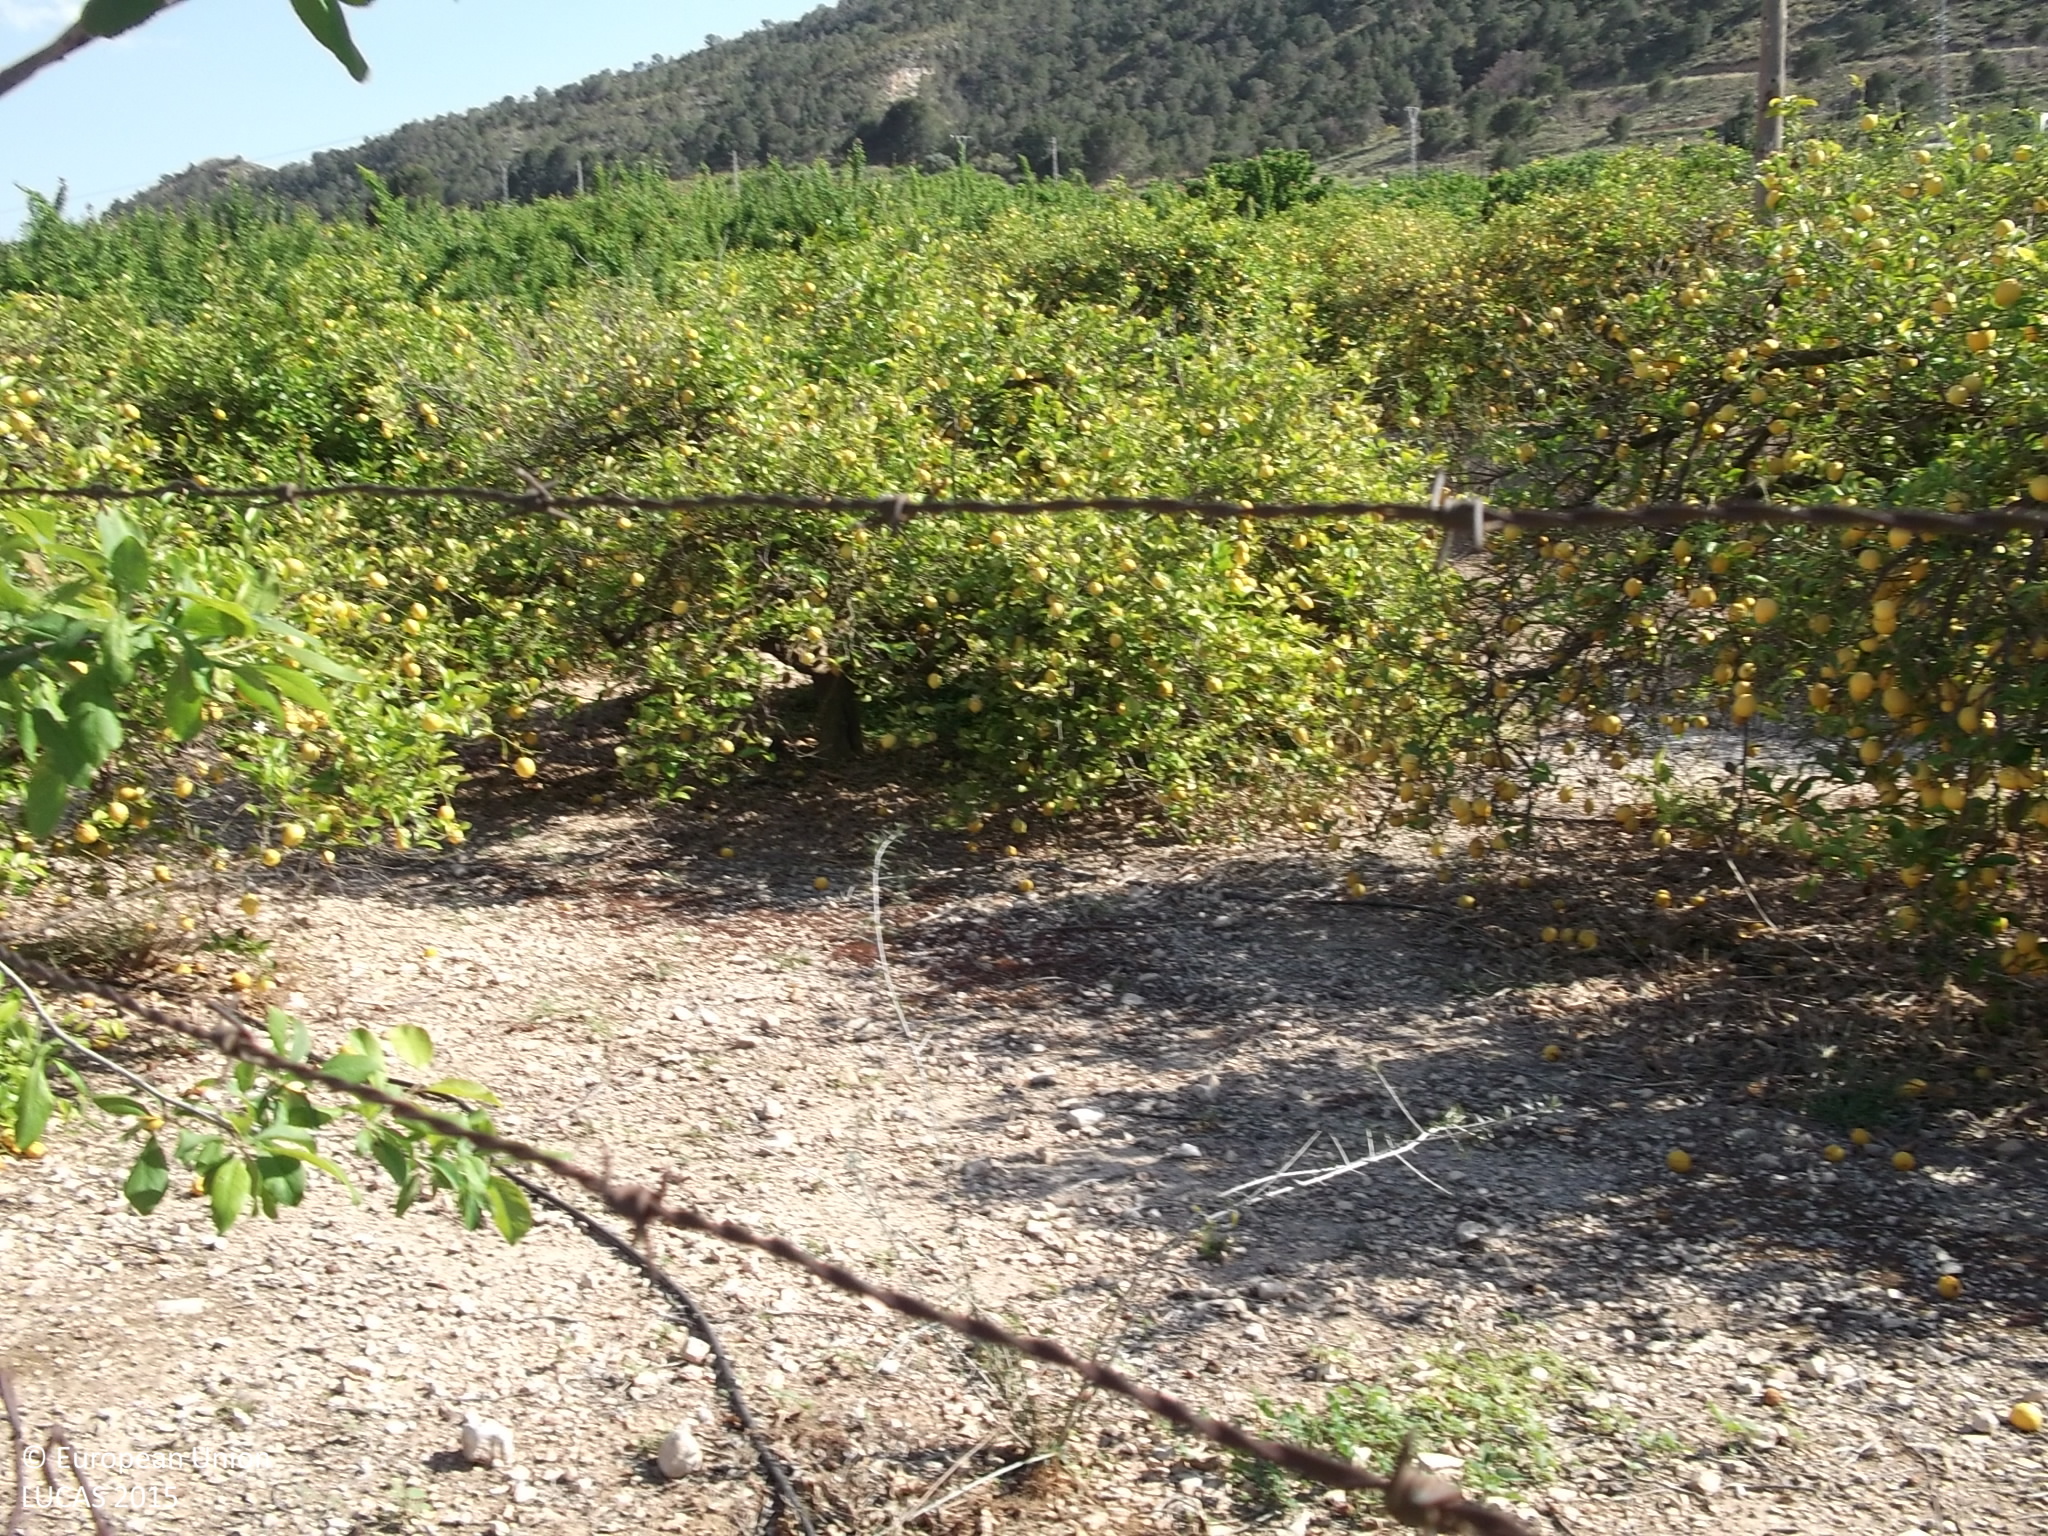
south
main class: Cropland
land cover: Other citrus fruit
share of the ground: 25 - 50 %
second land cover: Spontaneously vegetated surfaces
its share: > 75 %
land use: Agriculture (excluding fallow land and kitchen gardens)
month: April
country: ES
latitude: 38.1846
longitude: -1.3240
